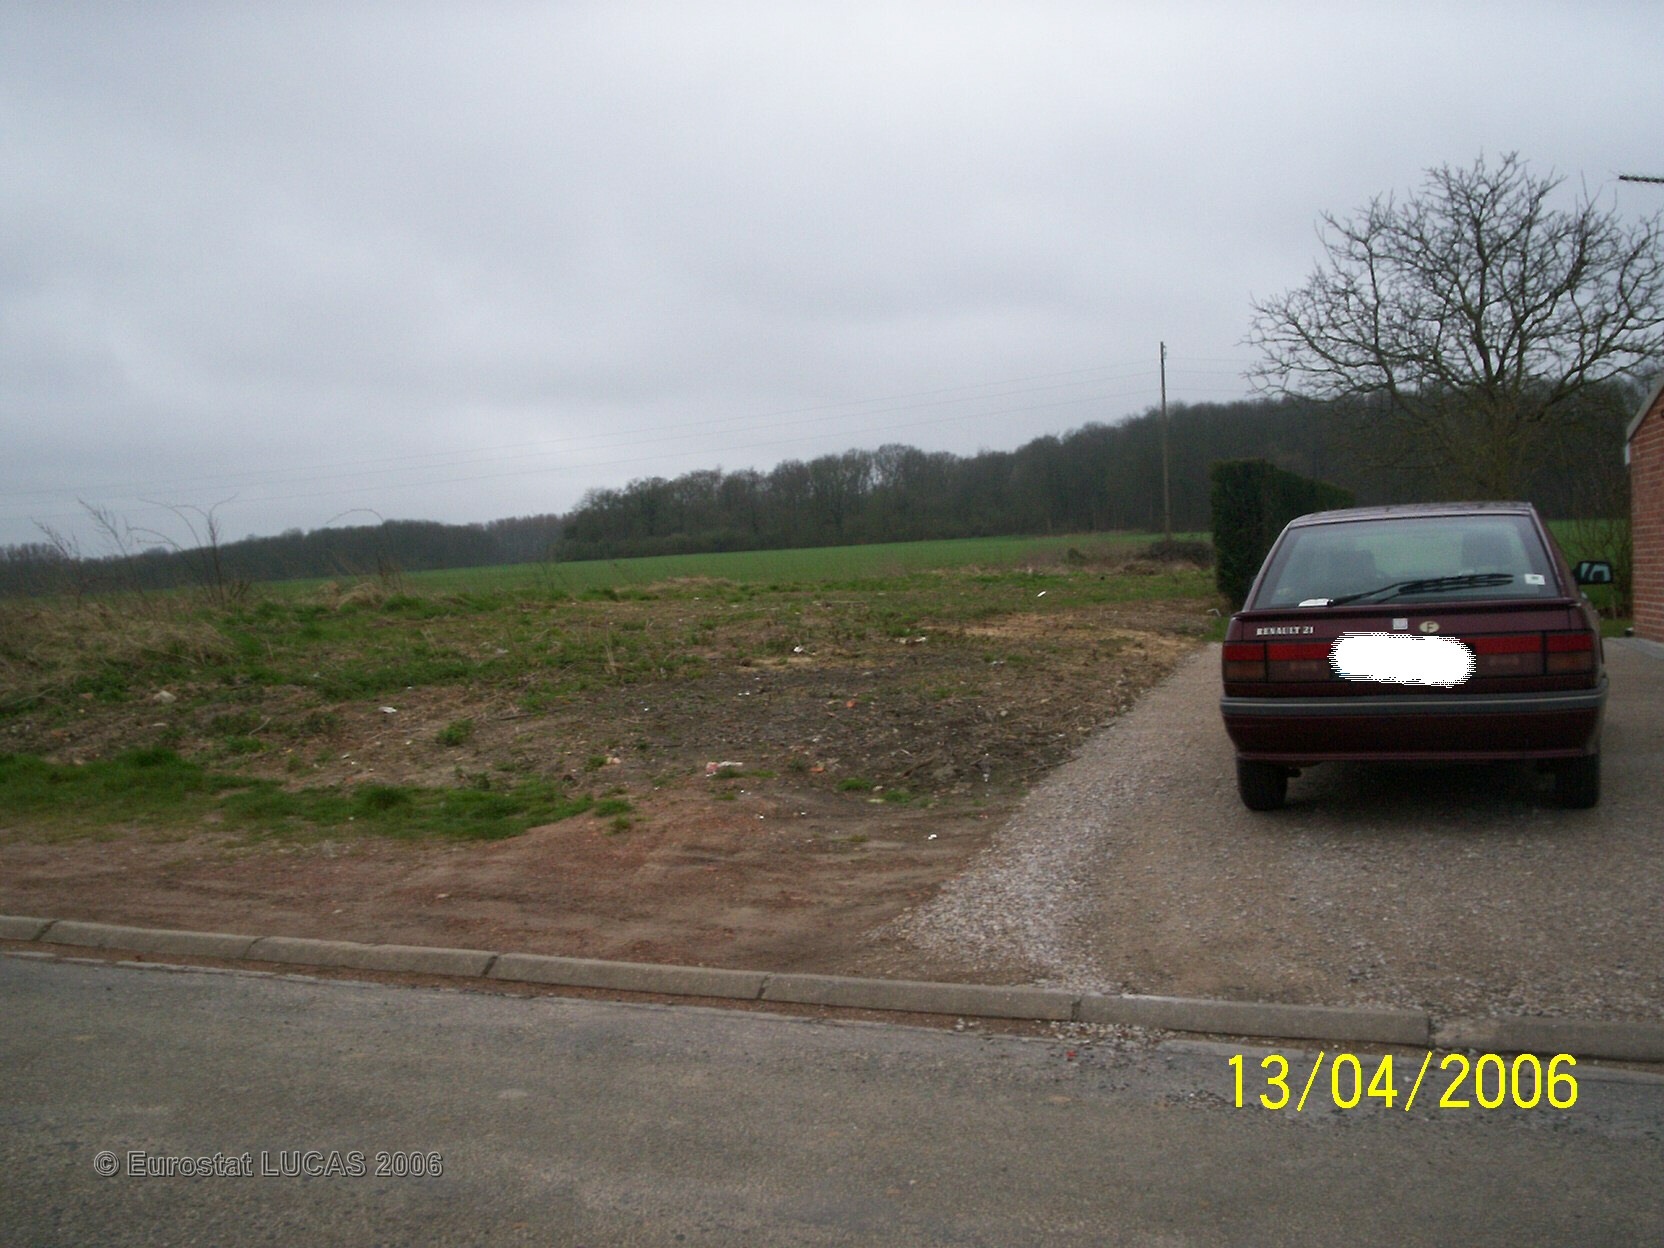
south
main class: Grassland
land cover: Grassland without tree/shrub cover
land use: Agriculture (excluding fallow land and kitchen gardens)
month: April
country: FR
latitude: 50.4613
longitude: 2.5073
